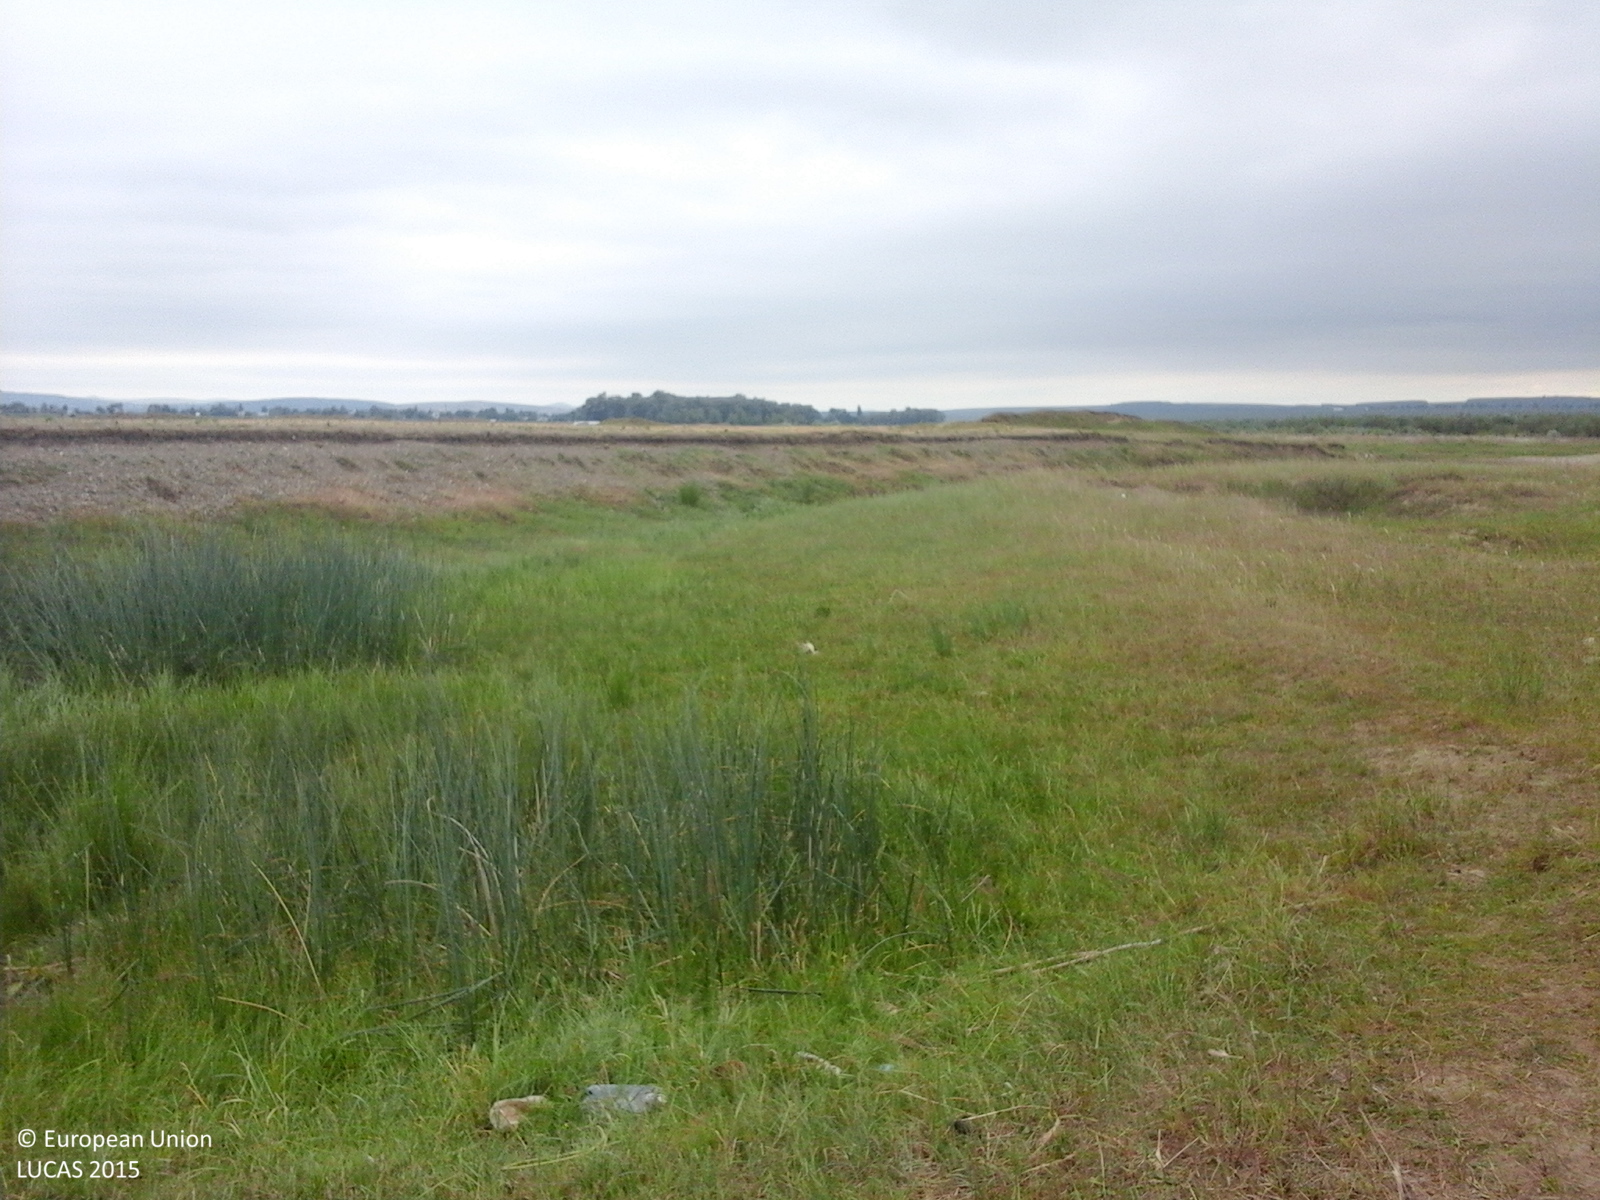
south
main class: Grassland
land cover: Grassland without tree/shrub cover
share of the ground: 25 - 50 %
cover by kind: herbaceous plants 100 %
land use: Agriculture (excluding fallow land and kitchen gardens)
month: June
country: RO
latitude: 47.1314
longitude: 26.6354
